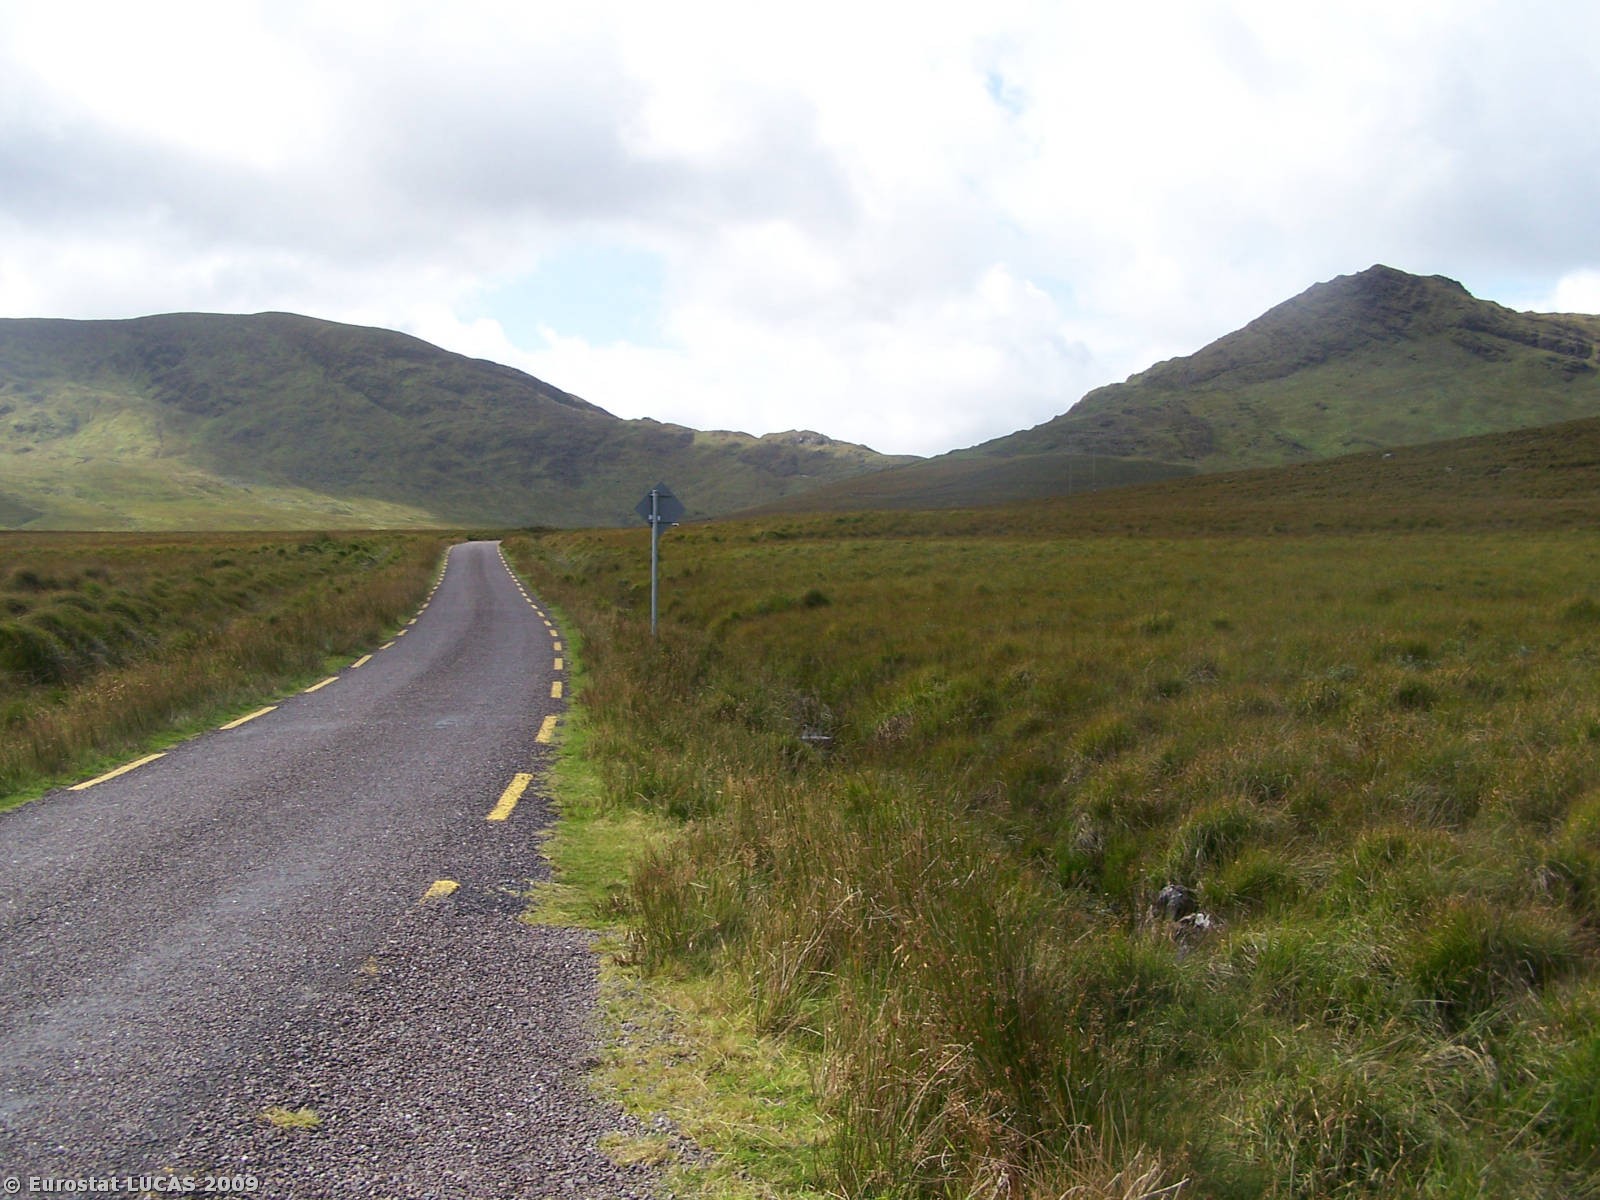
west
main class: Wetlands
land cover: Peatbogs
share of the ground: > 75 %
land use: Mining and quarrying
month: September
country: IE
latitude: 51.9631
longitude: -9.9125
